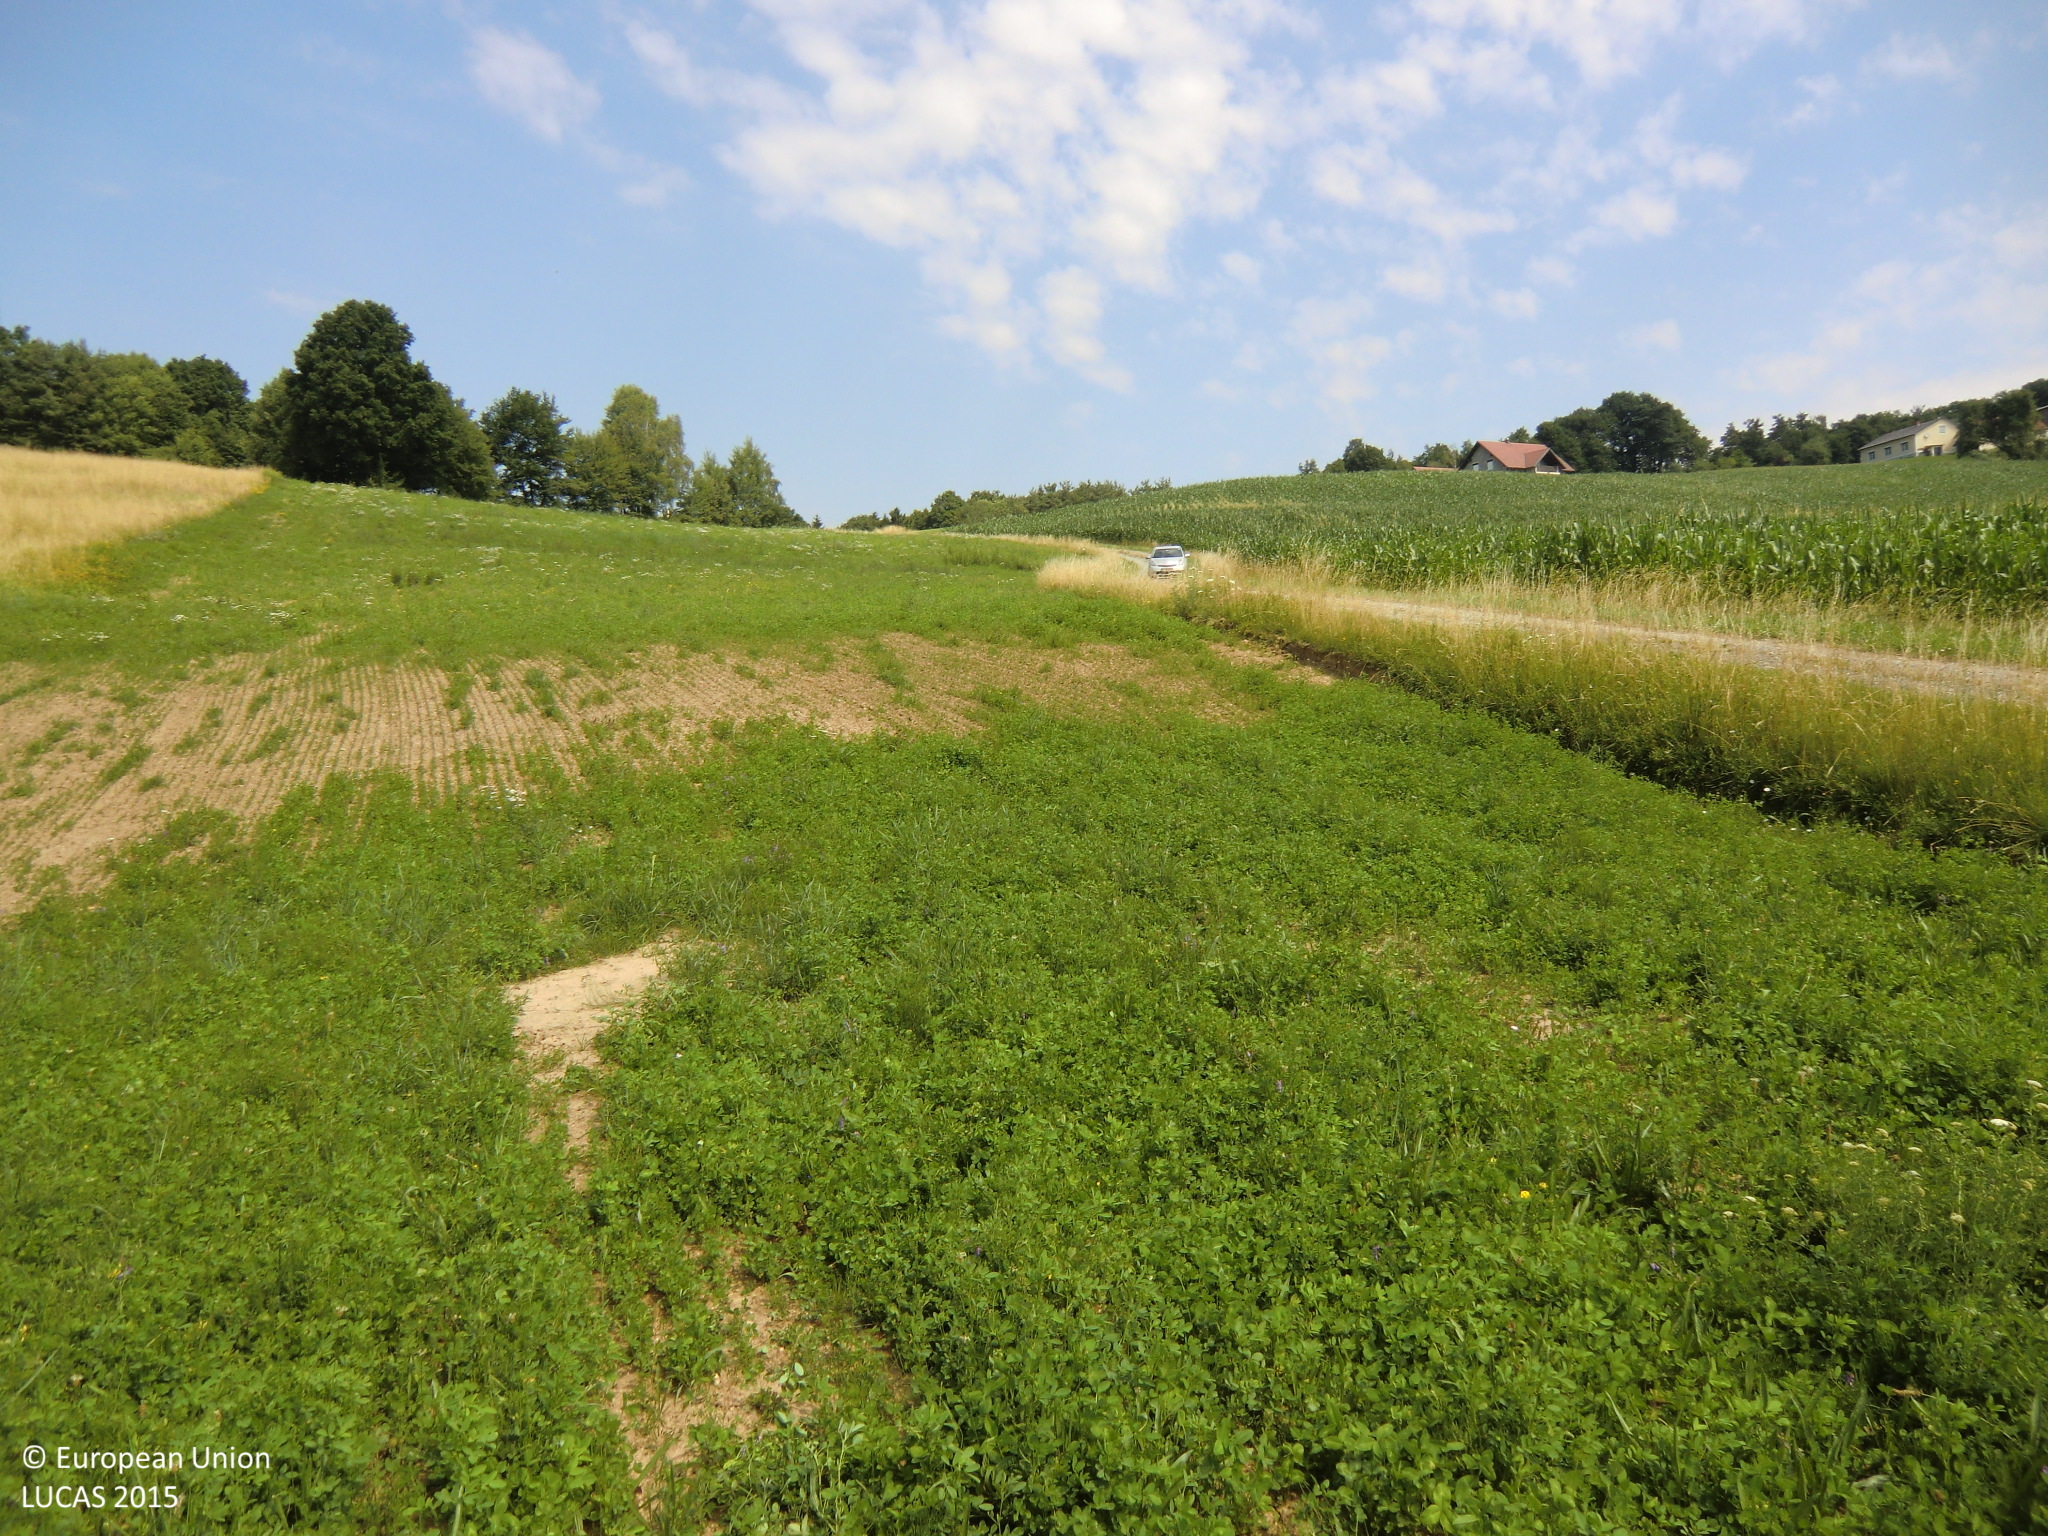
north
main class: Cropland
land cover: Clovers
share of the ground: > 75 %
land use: Agriculture (excluding fallow land and kitchen gardens)
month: July
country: AT
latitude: 47.0949
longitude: 16.1541
